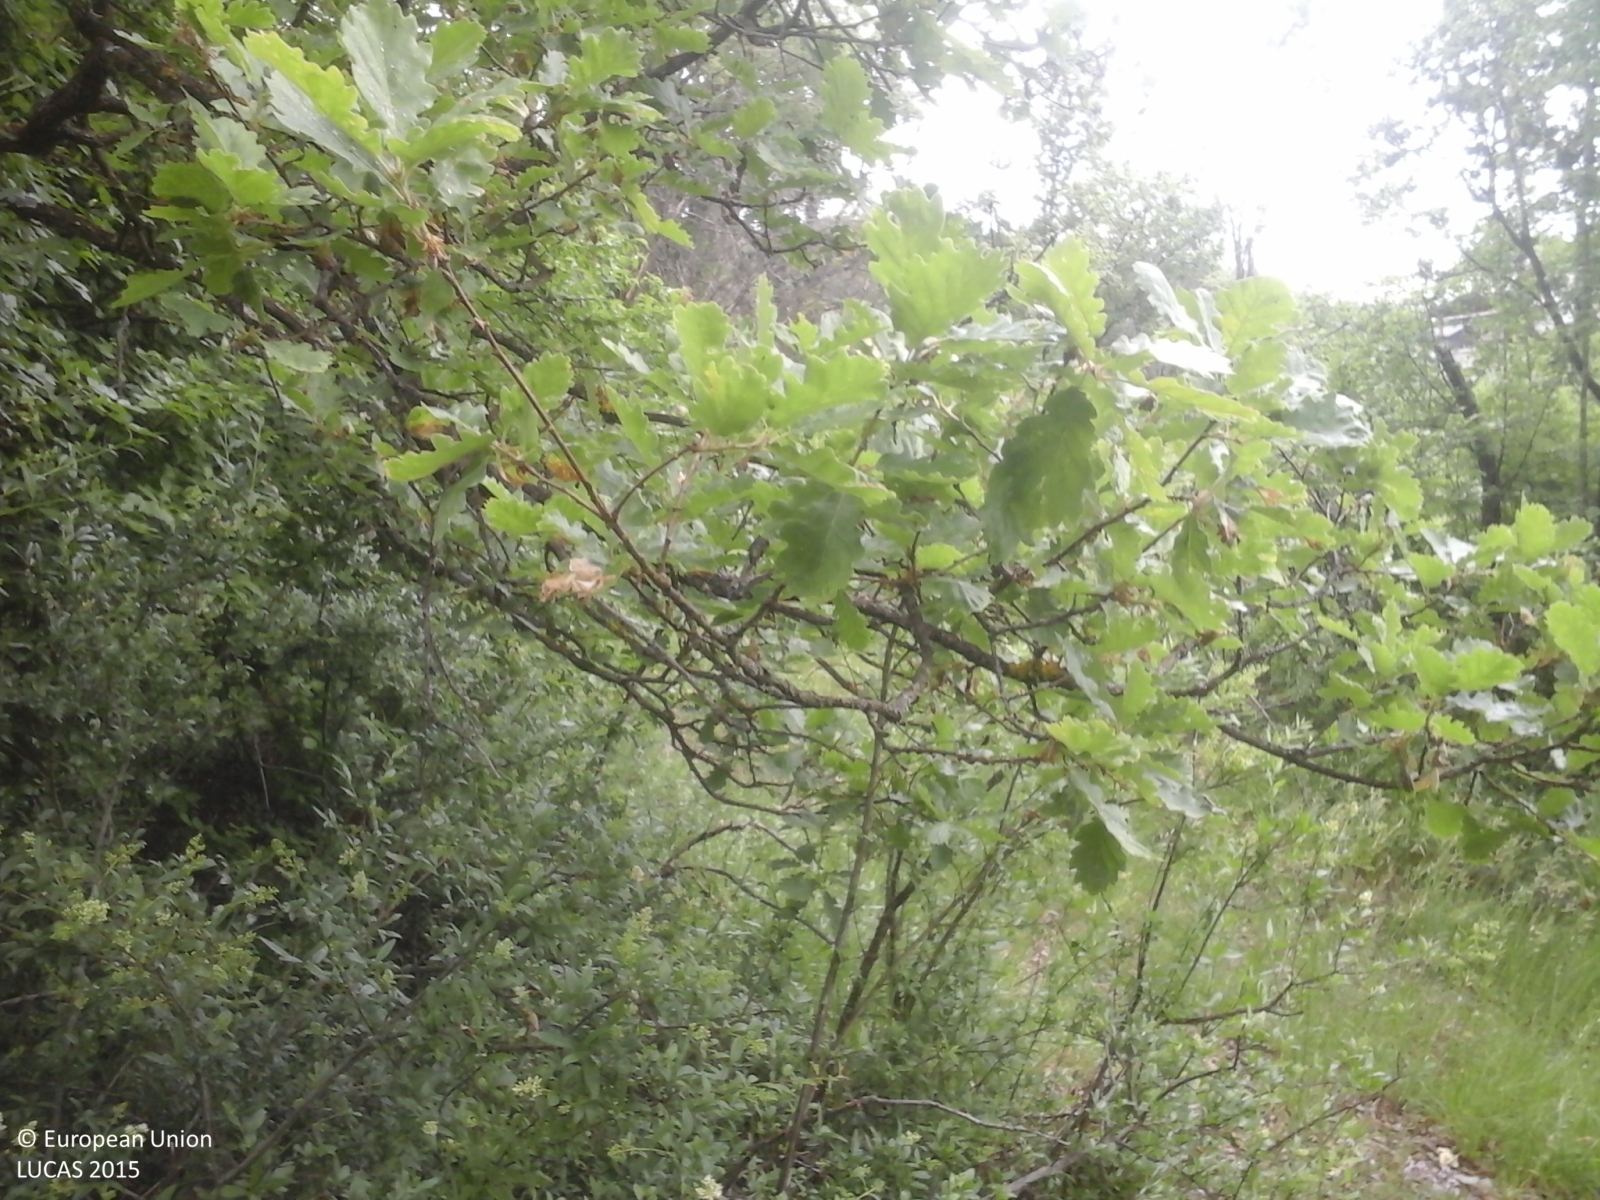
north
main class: Woodland
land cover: Broadleaved woodland
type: thermophilous deciduous forest
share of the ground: > 75 %
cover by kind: broadleaved forest trees 90 %, shrubs 10 %
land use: Forestry
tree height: > 5 m
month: May
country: IT
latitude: 44.2748
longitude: 10.8625
